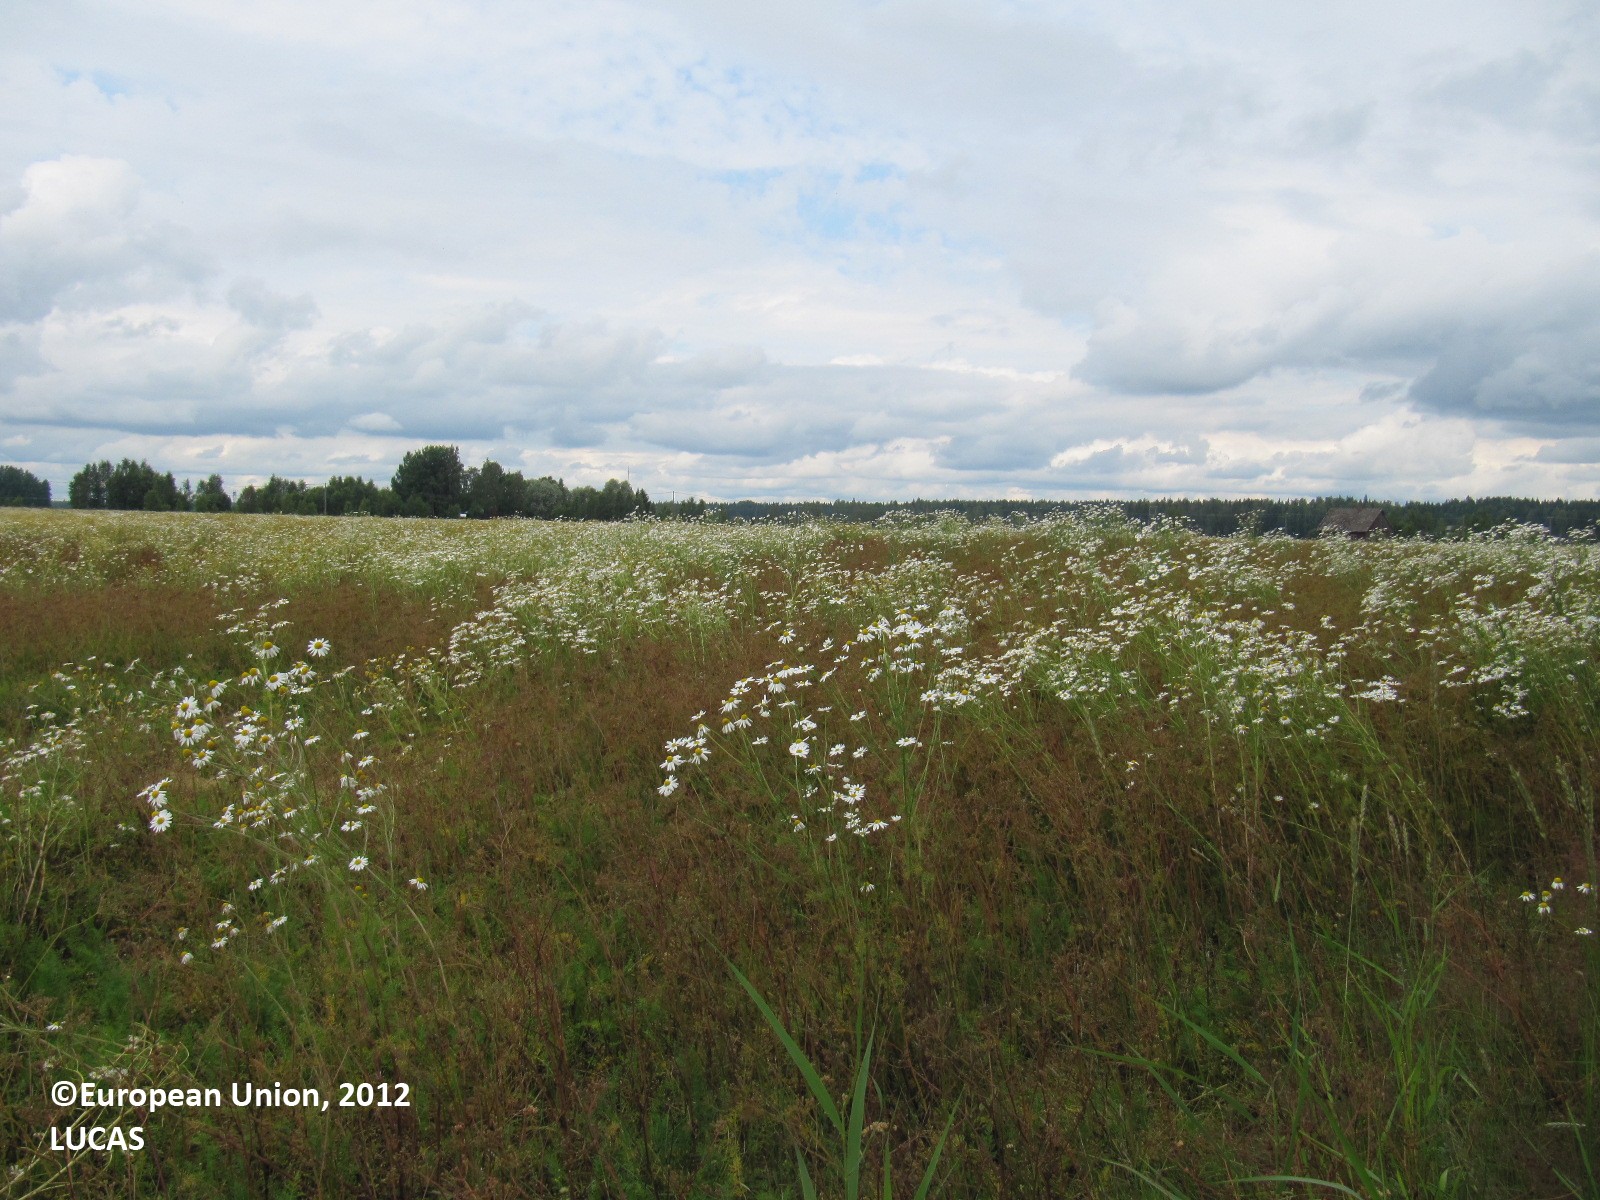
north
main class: Cropland
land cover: Other non-permanent industrial crops
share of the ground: > 75 %
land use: Agriculture (excluding fallow land and kitchen gardens)
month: July
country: FI
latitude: 60.7219
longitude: 23.2609
